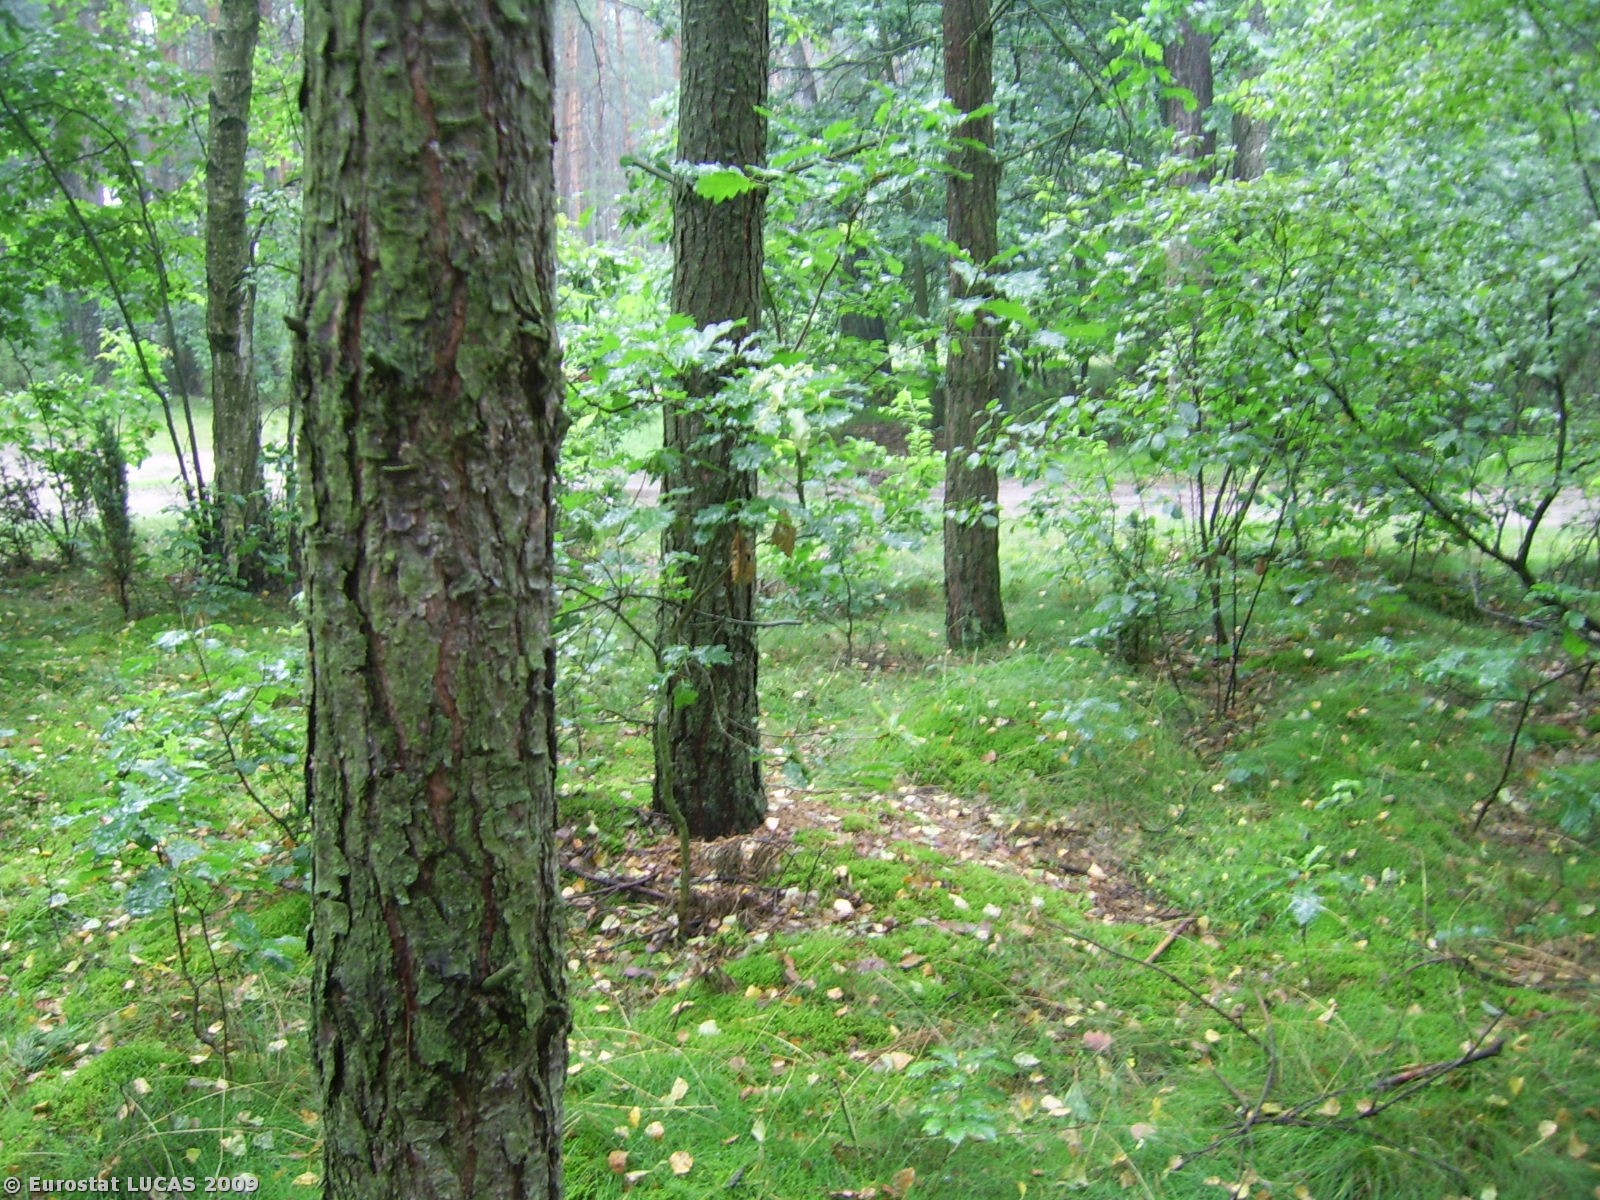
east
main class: Woodland
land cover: Coniferous woodland
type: hemiboreal forest and nemoral coniferous forest and mixed broadleaved-coniferous forest
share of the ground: 50 - 75 %
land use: Forestry
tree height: > 5 m
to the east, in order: Coniferous woodland; Tracks; Coniferous woodland
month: August
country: PL
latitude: 52.8884
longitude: 18.7149
